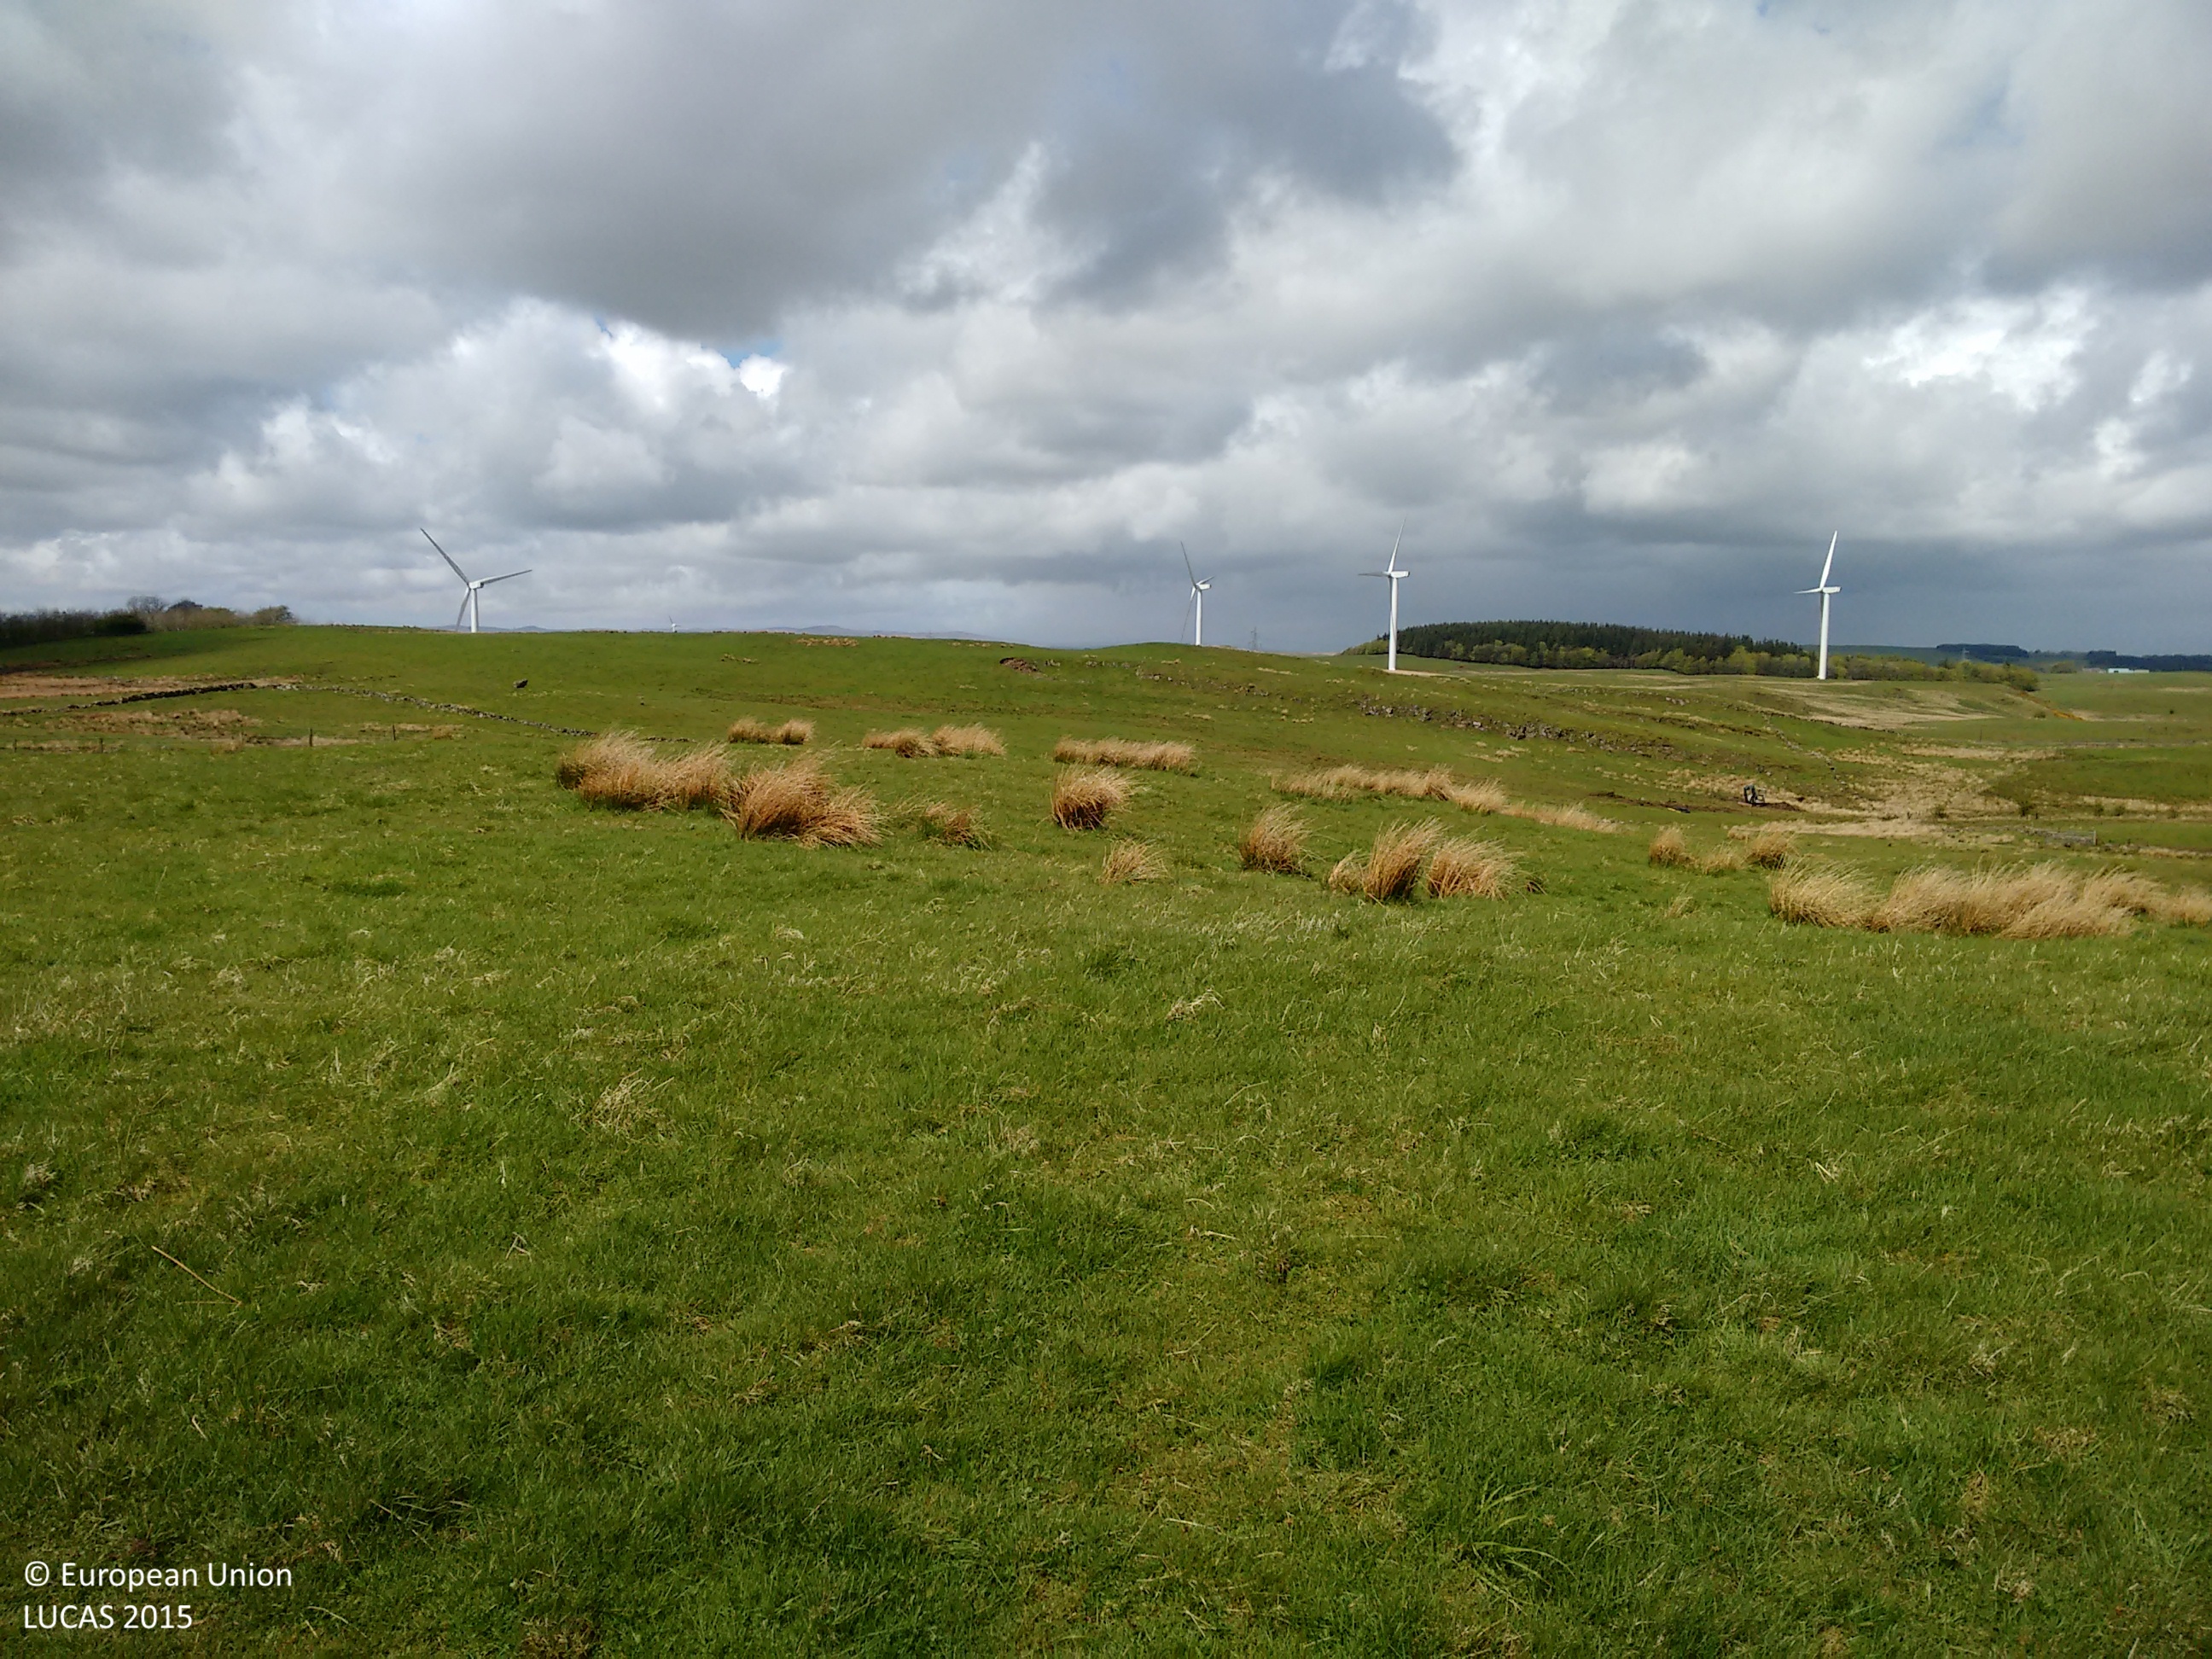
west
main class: Grassland
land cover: Grassland without tree/shrub cover
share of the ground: > 75 %
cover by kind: herbaceous plants 100 %
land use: Agriculture (excluding fallow land and kitchen gardens)
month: May
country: GB
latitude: 55.7478
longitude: -4.4519
